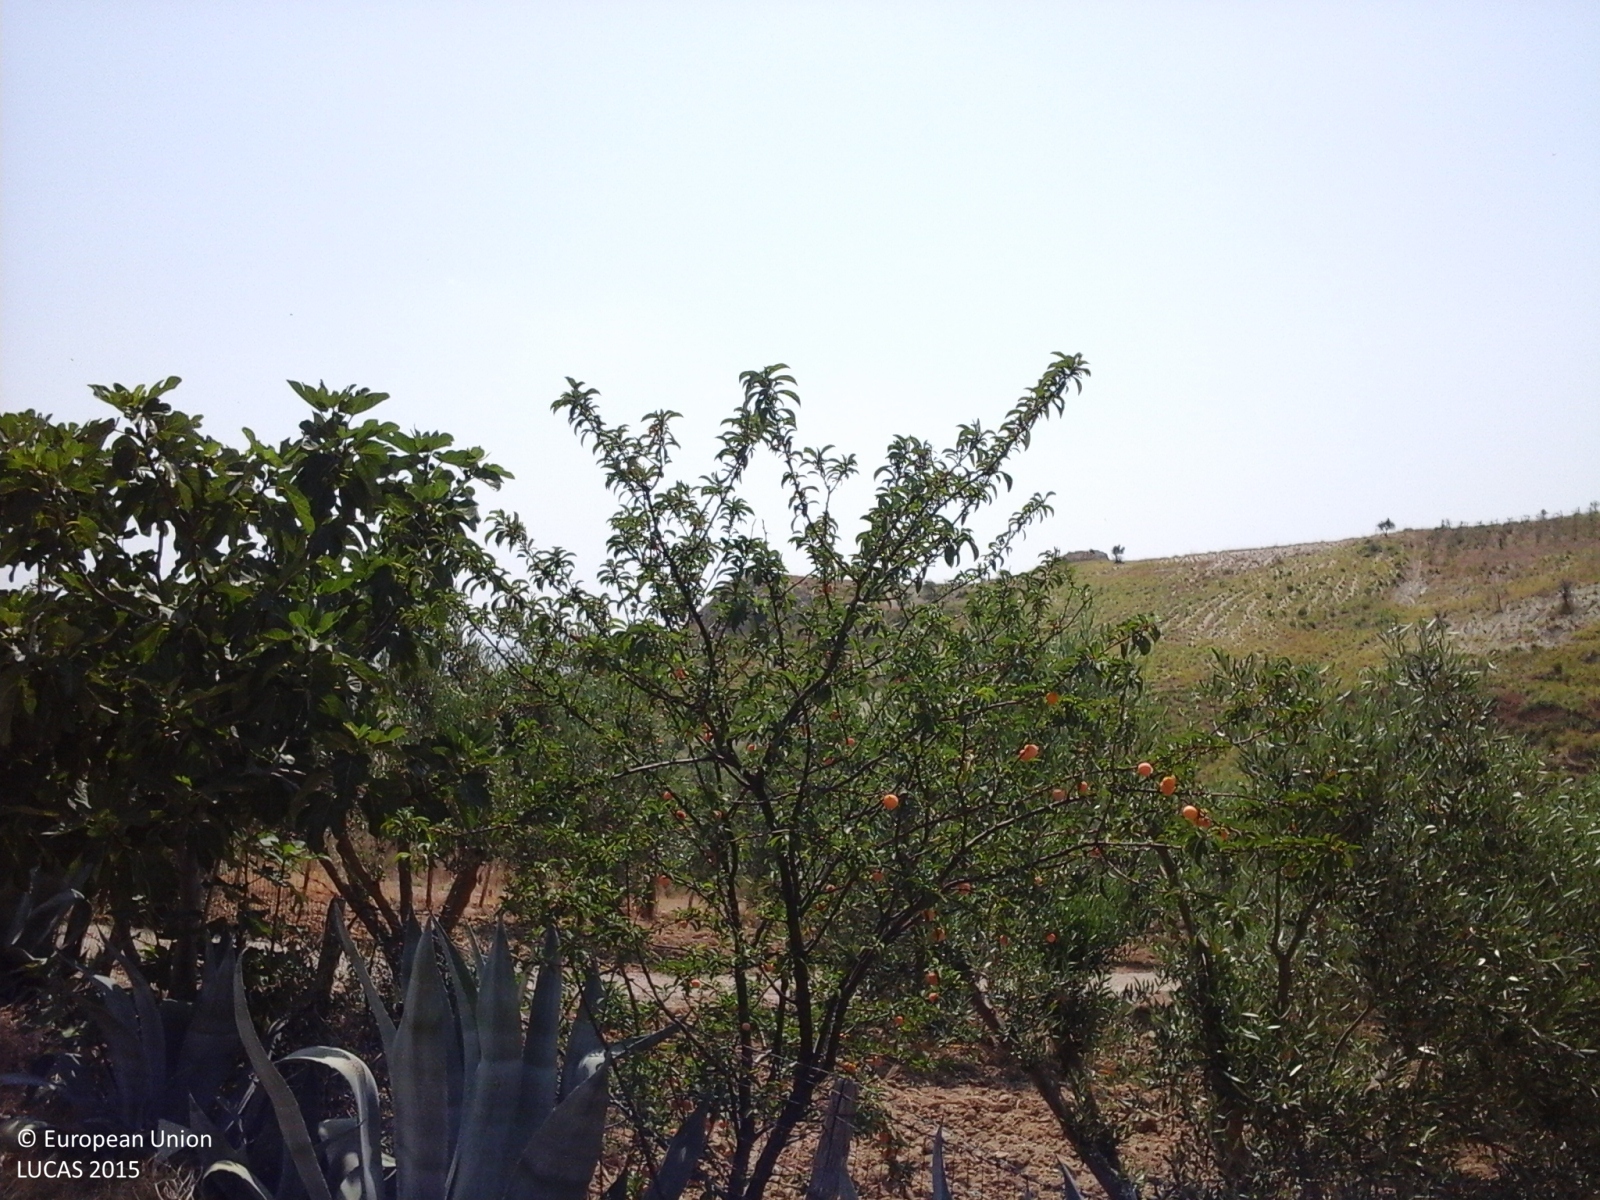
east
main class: Shrubland
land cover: Shrubland without tree cover
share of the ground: > 75 %
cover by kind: shrubs 60 %, herbaceous plants 40 %
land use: Semi-natural and natural areas not in use
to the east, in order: Shrubland without tree cover; Grassland without tree/shrub cover; Durum wheat
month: July
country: IT
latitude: 37.3716
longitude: 14.0232
